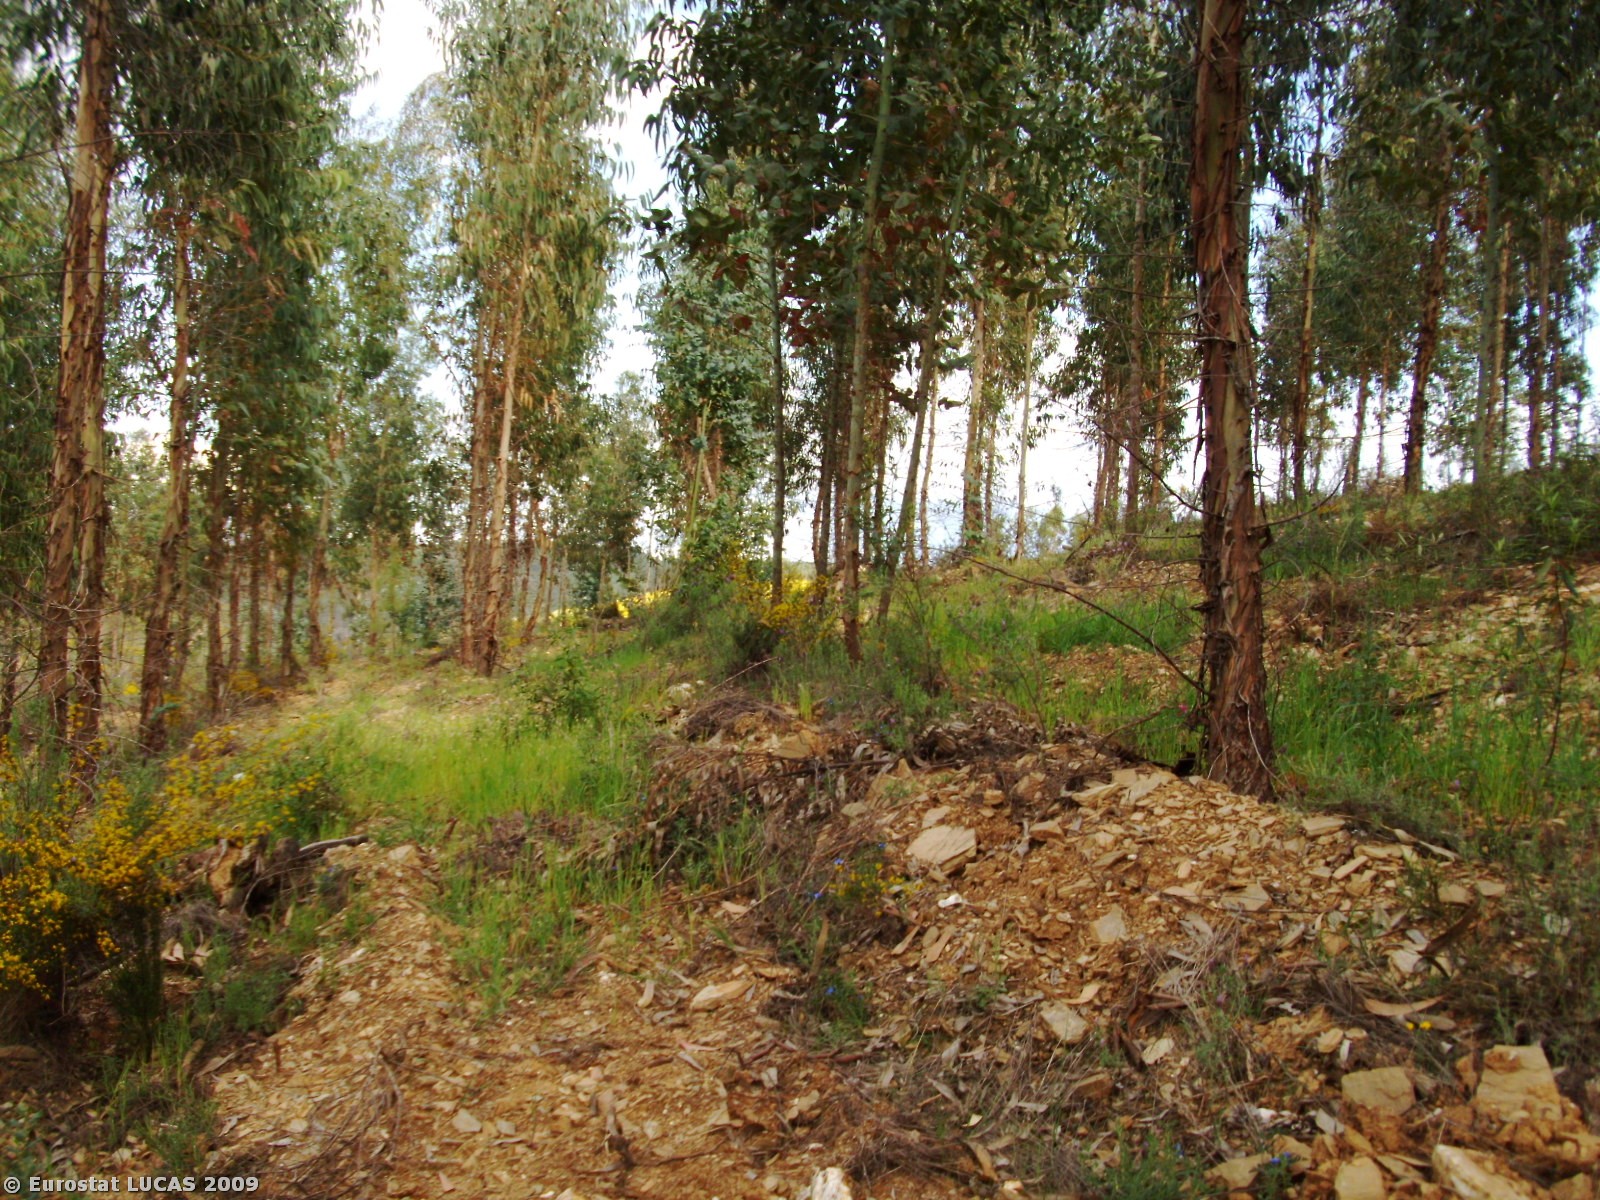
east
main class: Woodland
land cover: Broadleaved woodland
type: plantations and self-sown exotic forest
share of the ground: 25 - 50 %
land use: Forestry
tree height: > 5 m
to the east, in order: Broadleaved woodland; Tracks; Broadleaved woodland; Tracks; Shrubland without tree cover; Rivers and streams; Shrubland with sparse tree cover
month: April
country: PT
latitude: 39.8092
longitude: -7.5873
